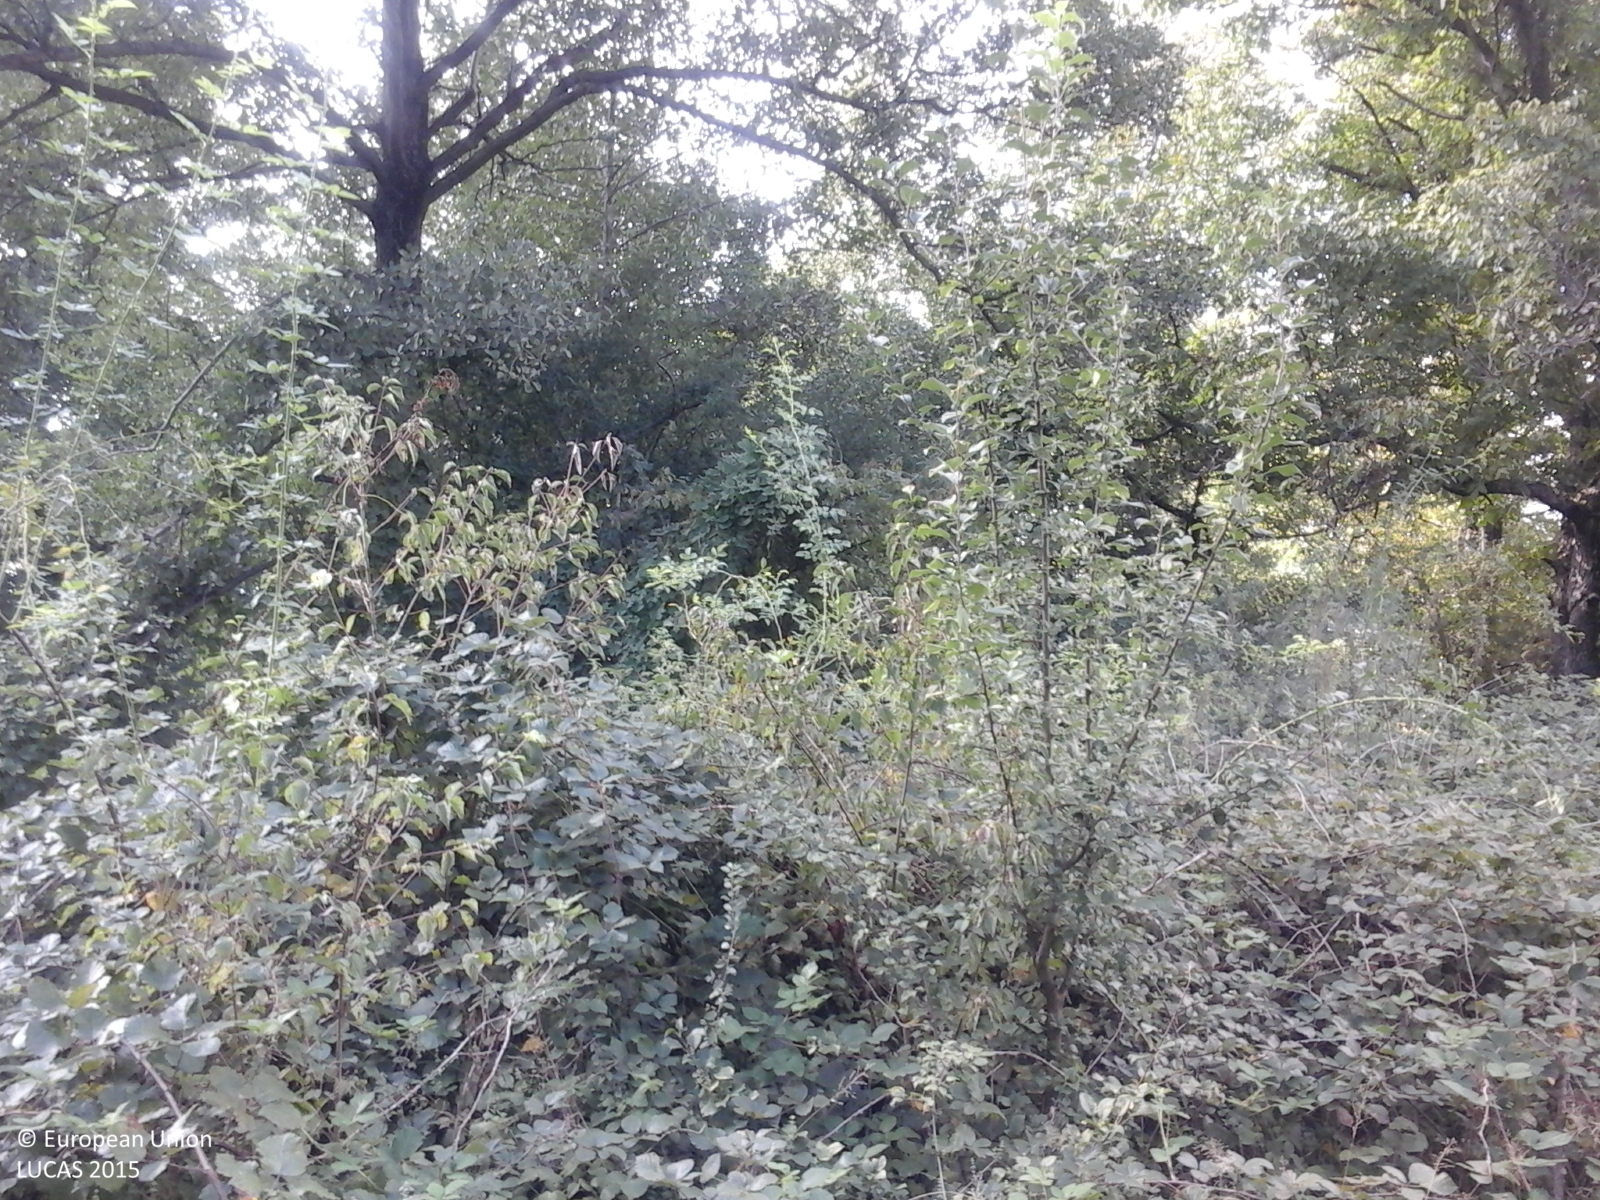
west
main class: Woodland
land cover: Broadleaved woodland
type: beech forest
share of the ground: > 75 %
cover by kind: broadleaved forest trees 100 %
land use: Forestry
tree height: > 5 m
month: September
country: RO
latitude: 45.1293
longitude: 23.4716
